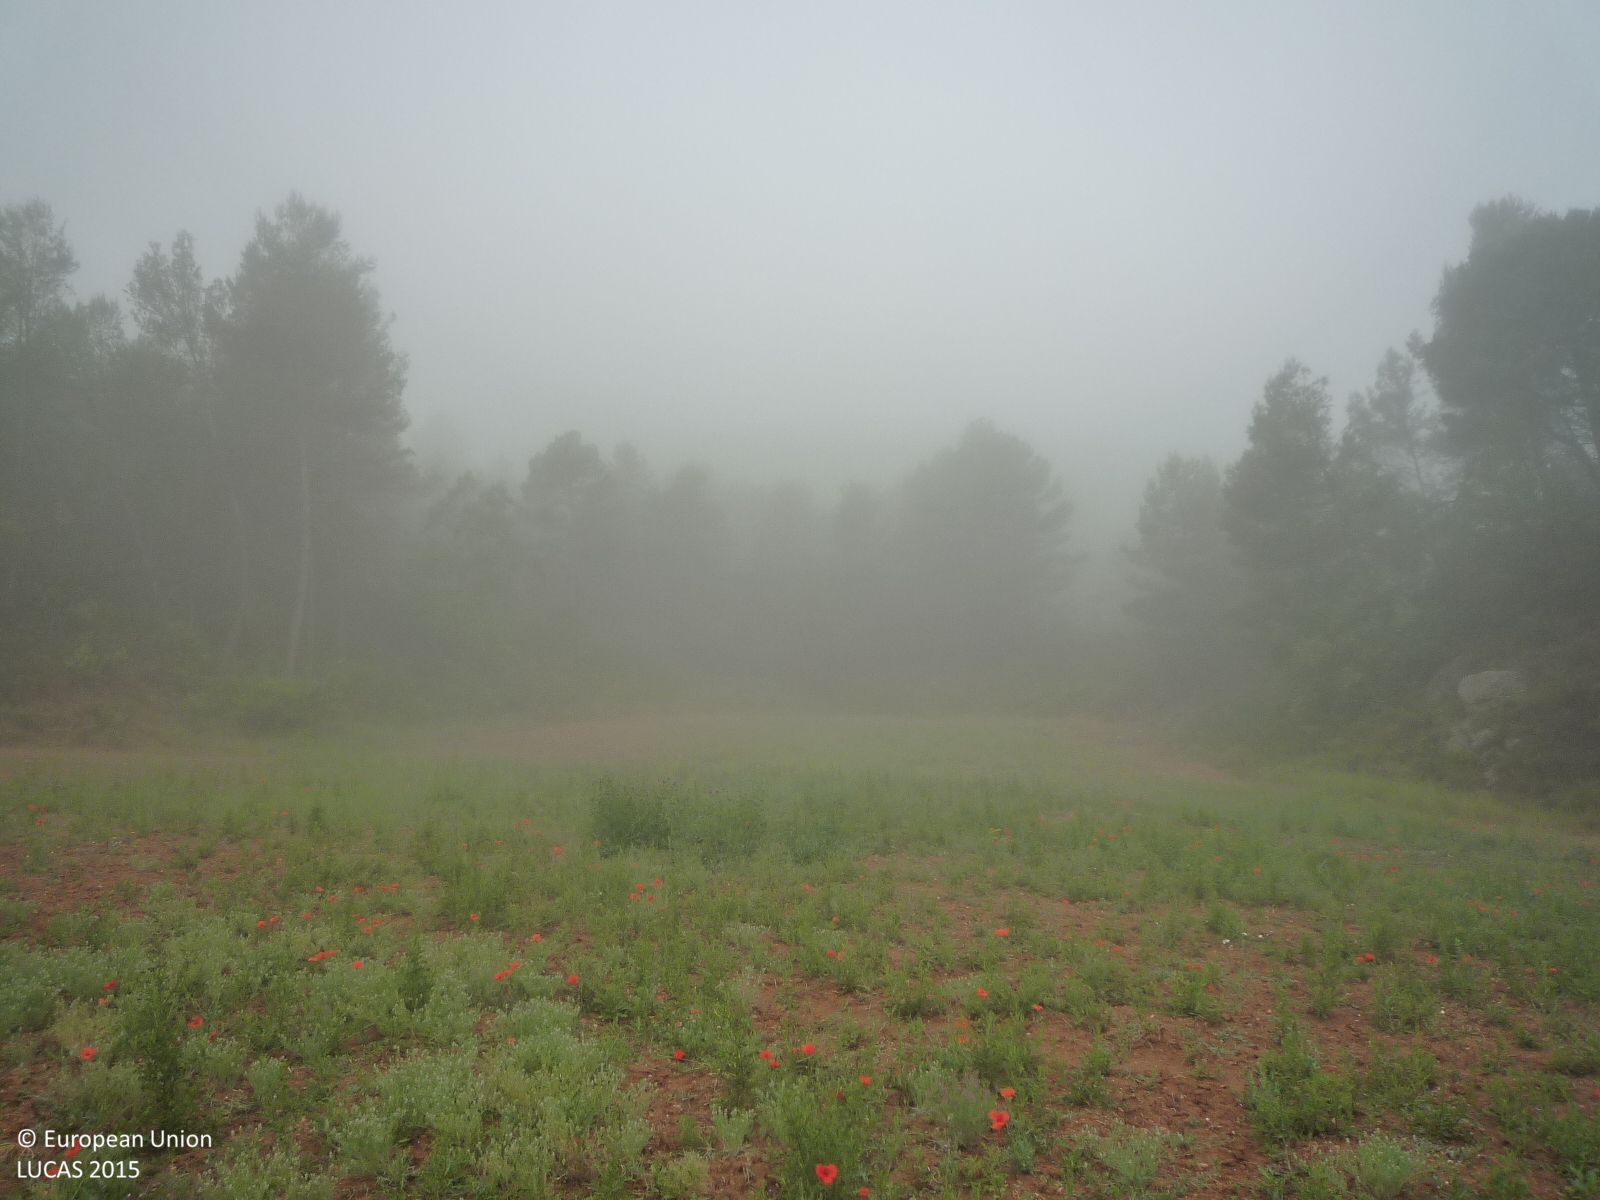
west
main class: Grassland
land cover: Grassland without tree/shrub cover
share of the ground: > 75 %
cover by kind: herbaceous plants 100 %
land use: Abandoned areas
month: June
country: ES
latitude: 41.6648
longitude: 1.7646
